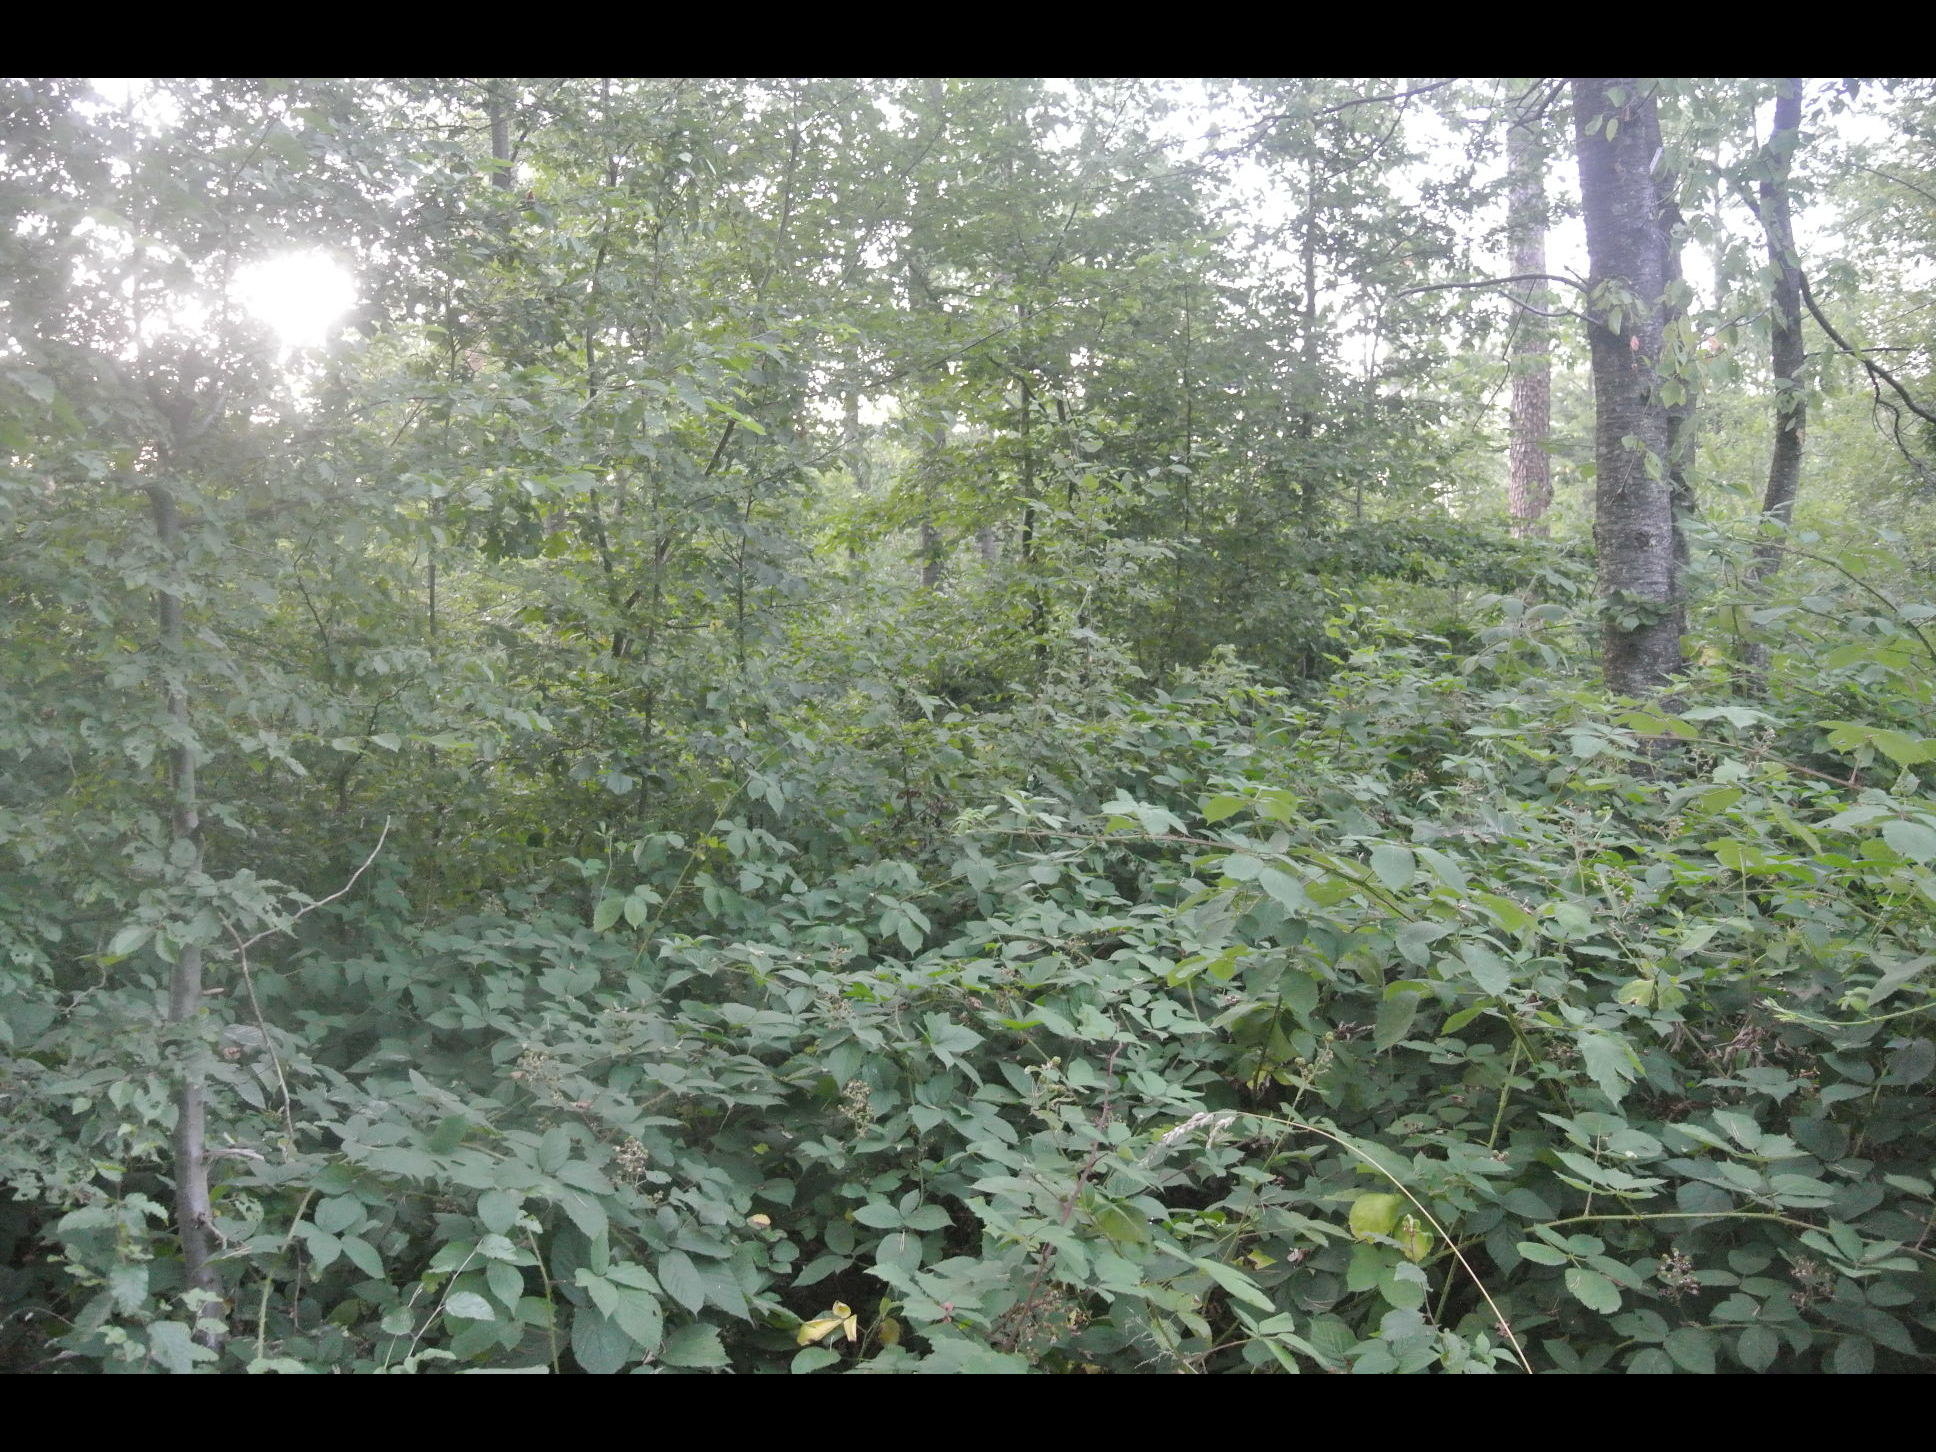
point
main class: Woodland
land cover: Pine dominated mixed woodland
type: alpine coniferous forest
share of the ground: > 75 %
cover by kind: broadleaved forest trees 75 %, coniferous forest trees 25 %
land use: Forestry
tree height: > 5 m
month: July
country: AT
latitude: 47.5832
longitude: 16.4525
